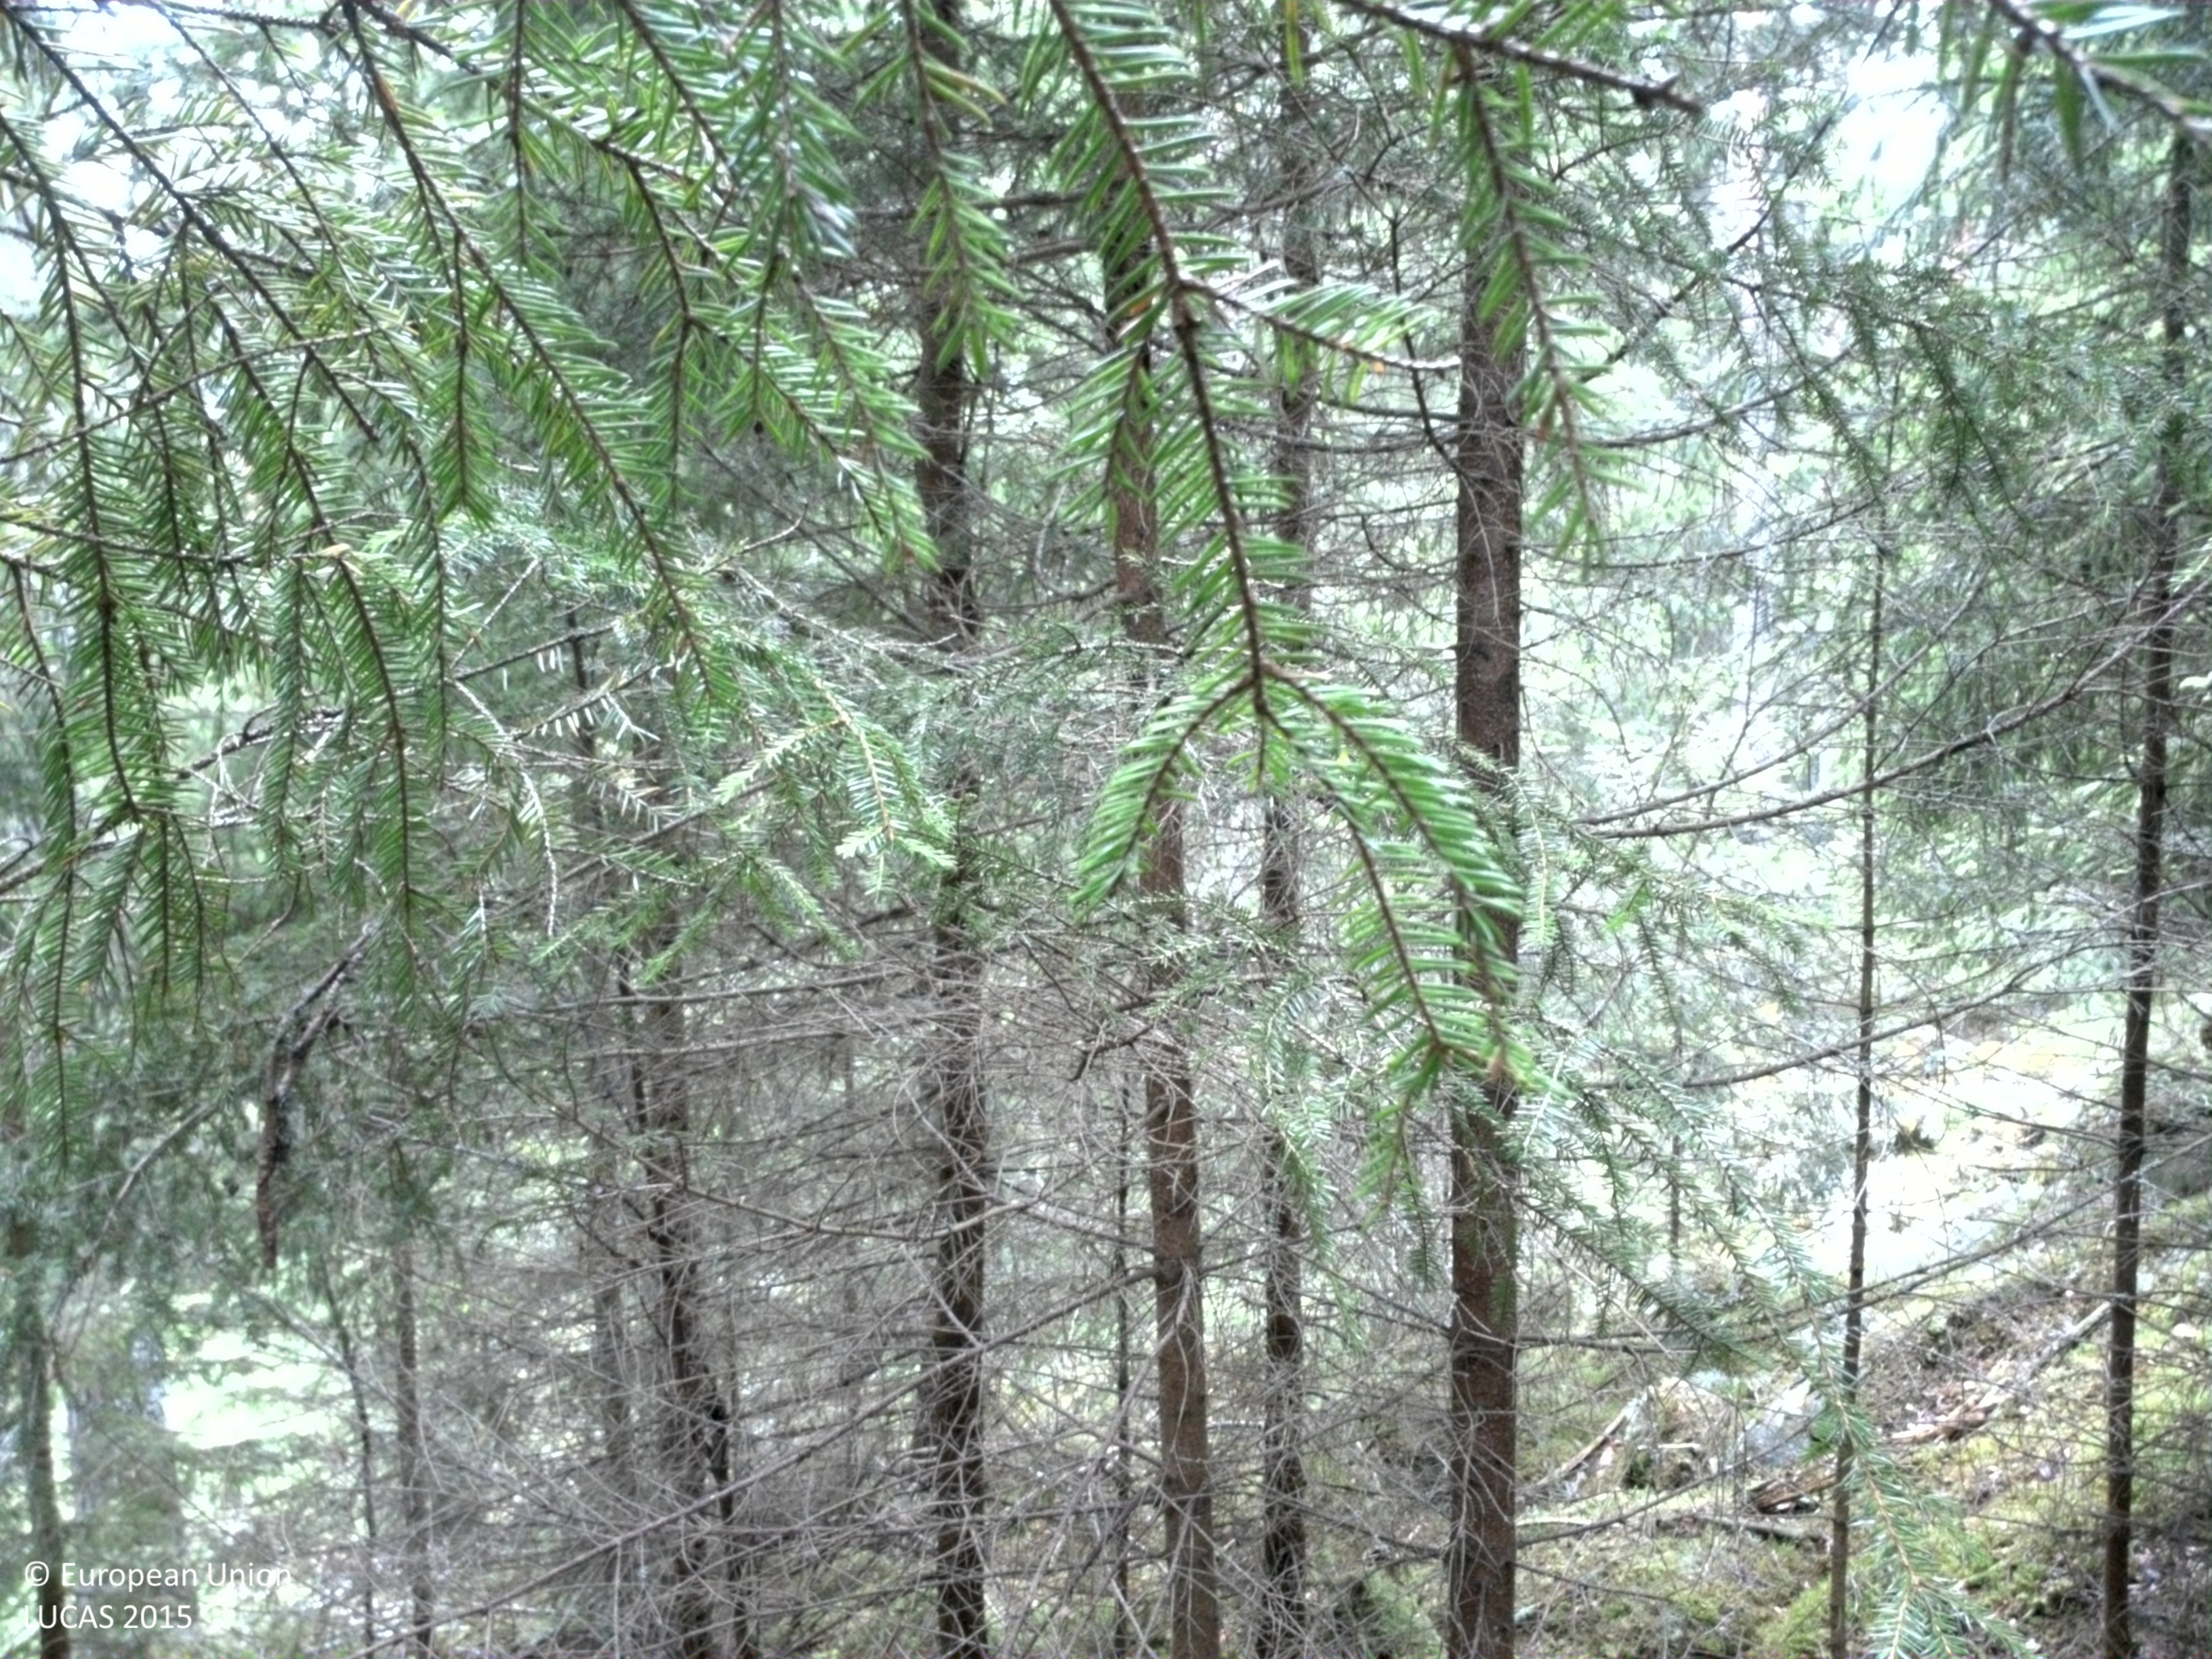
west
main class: Woodland
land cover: Spruce dominated coniferous woodland
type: boreal forest
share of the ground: 50 - 75 %
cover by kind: coniferous forest trees 70 %, lichens and mosses 25 %, shrubs 5 %
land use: Forestry
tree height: > 5 m
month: August
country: SE
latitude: 59.3565
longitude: 11.9826
